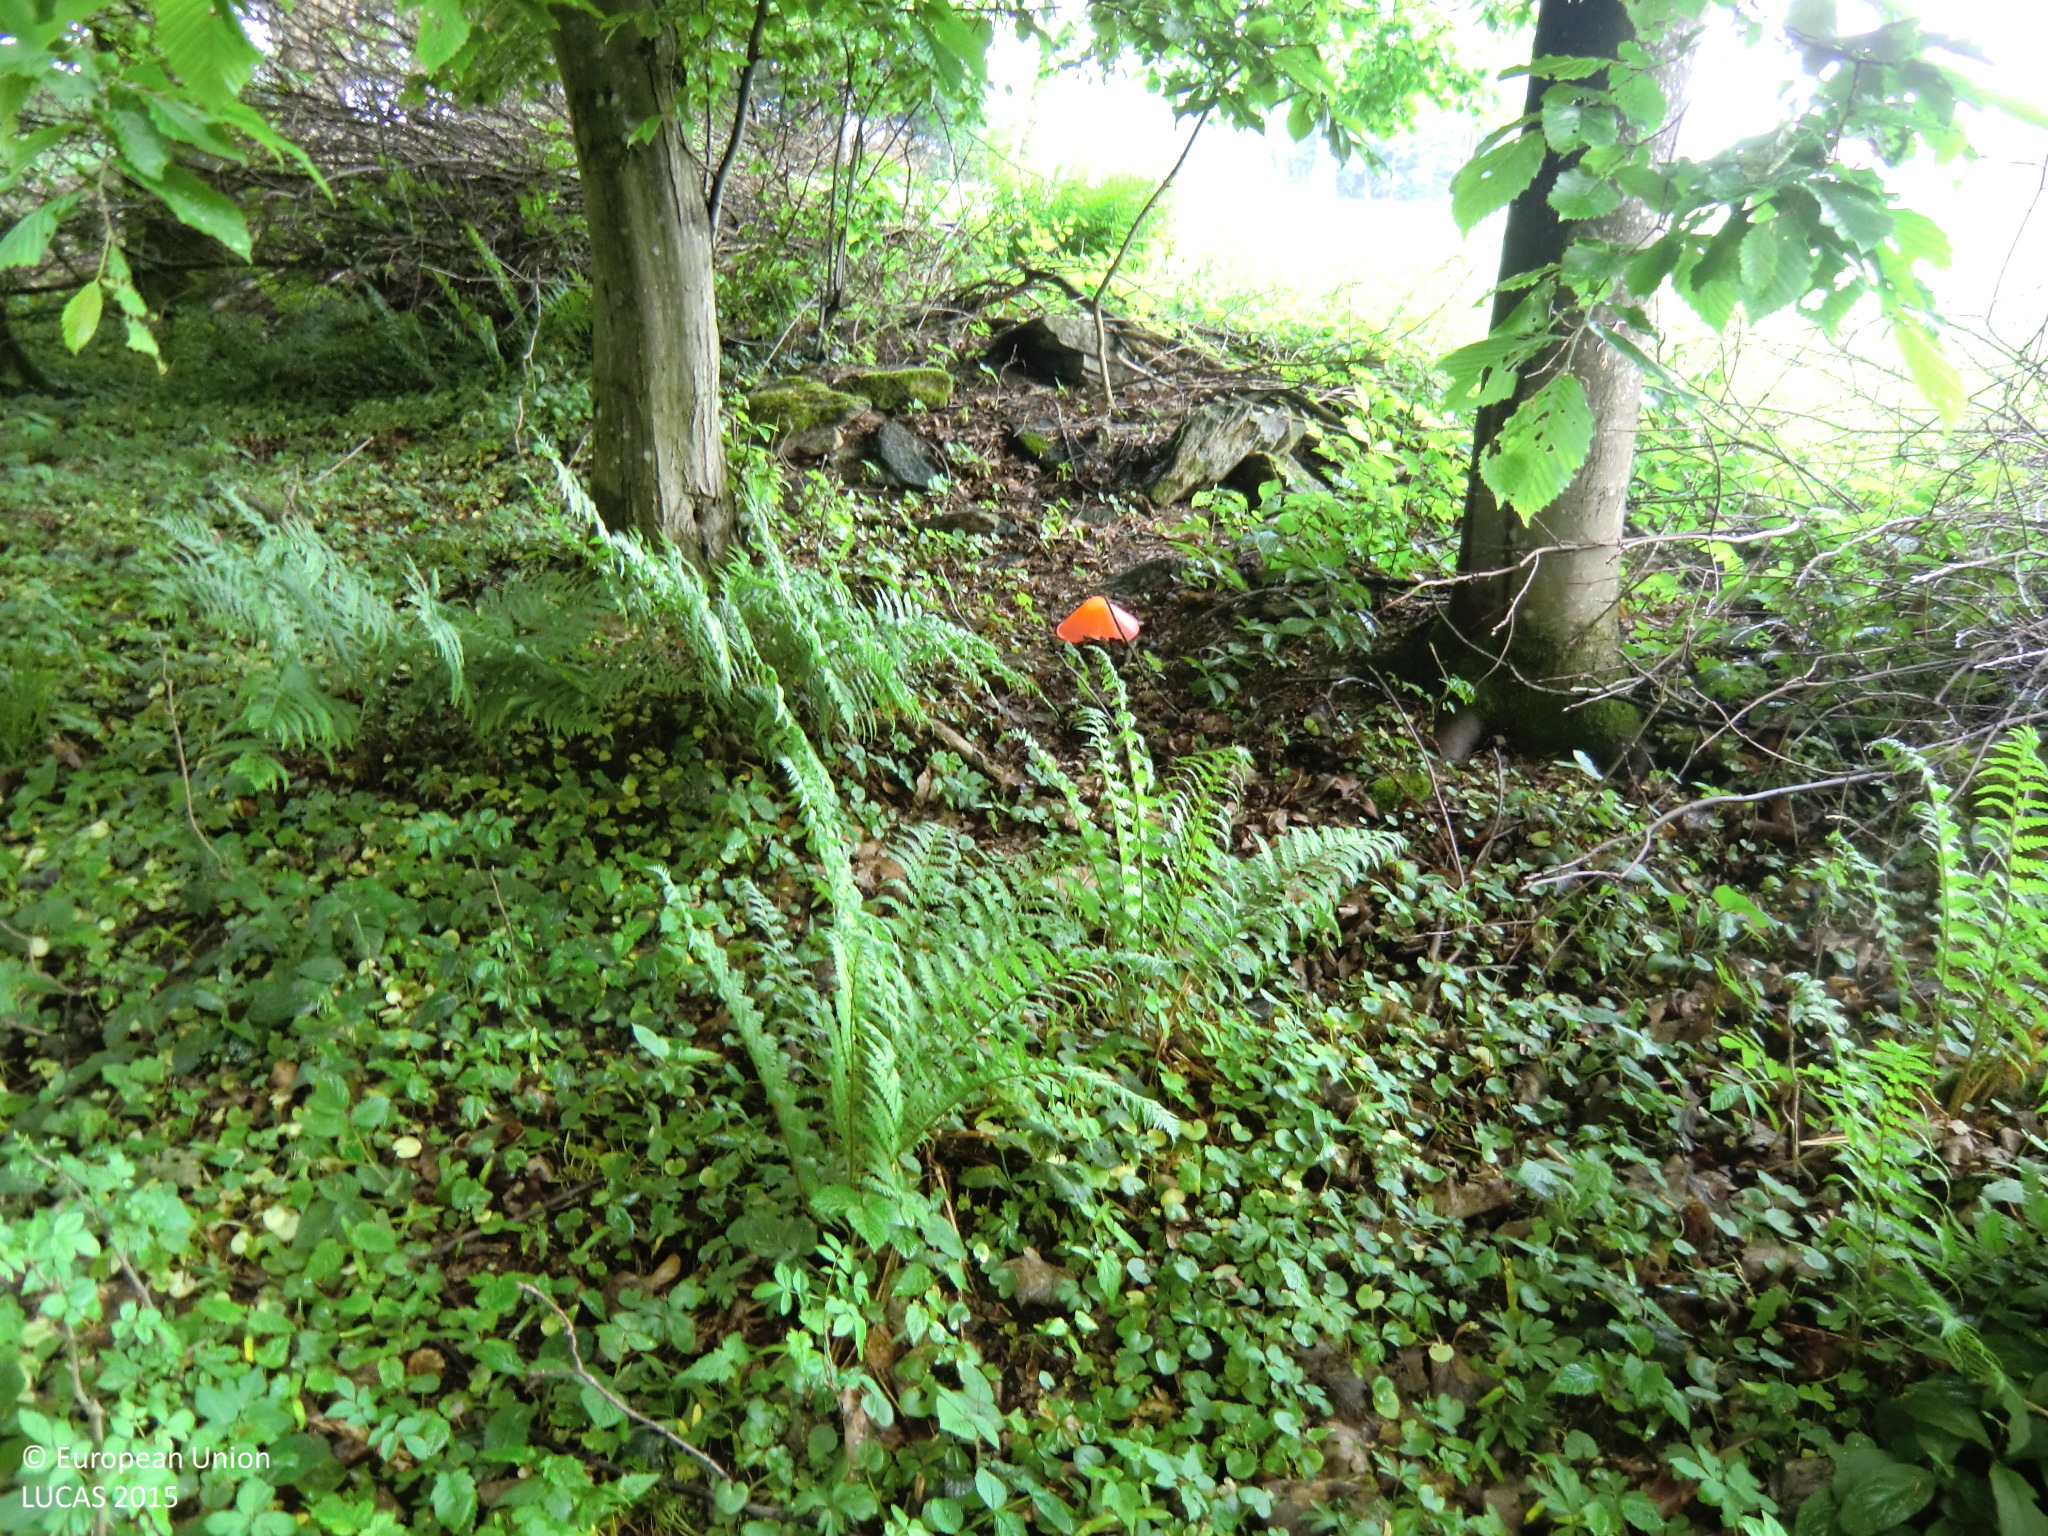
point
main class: Woodland
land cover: Broadleaved woodland
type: hemiboreal forest and nemoral coniferous forest and mixed broadleaved-coniferous forest
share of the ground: > 75 %
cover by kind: broadleaved forest trees 75 %, herbaceous plants 20 %, unconsolidated bare surface 5 %
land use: Forestry
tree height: > 5 m
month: May
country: AT
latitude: 48.3557
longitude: 14.3053
